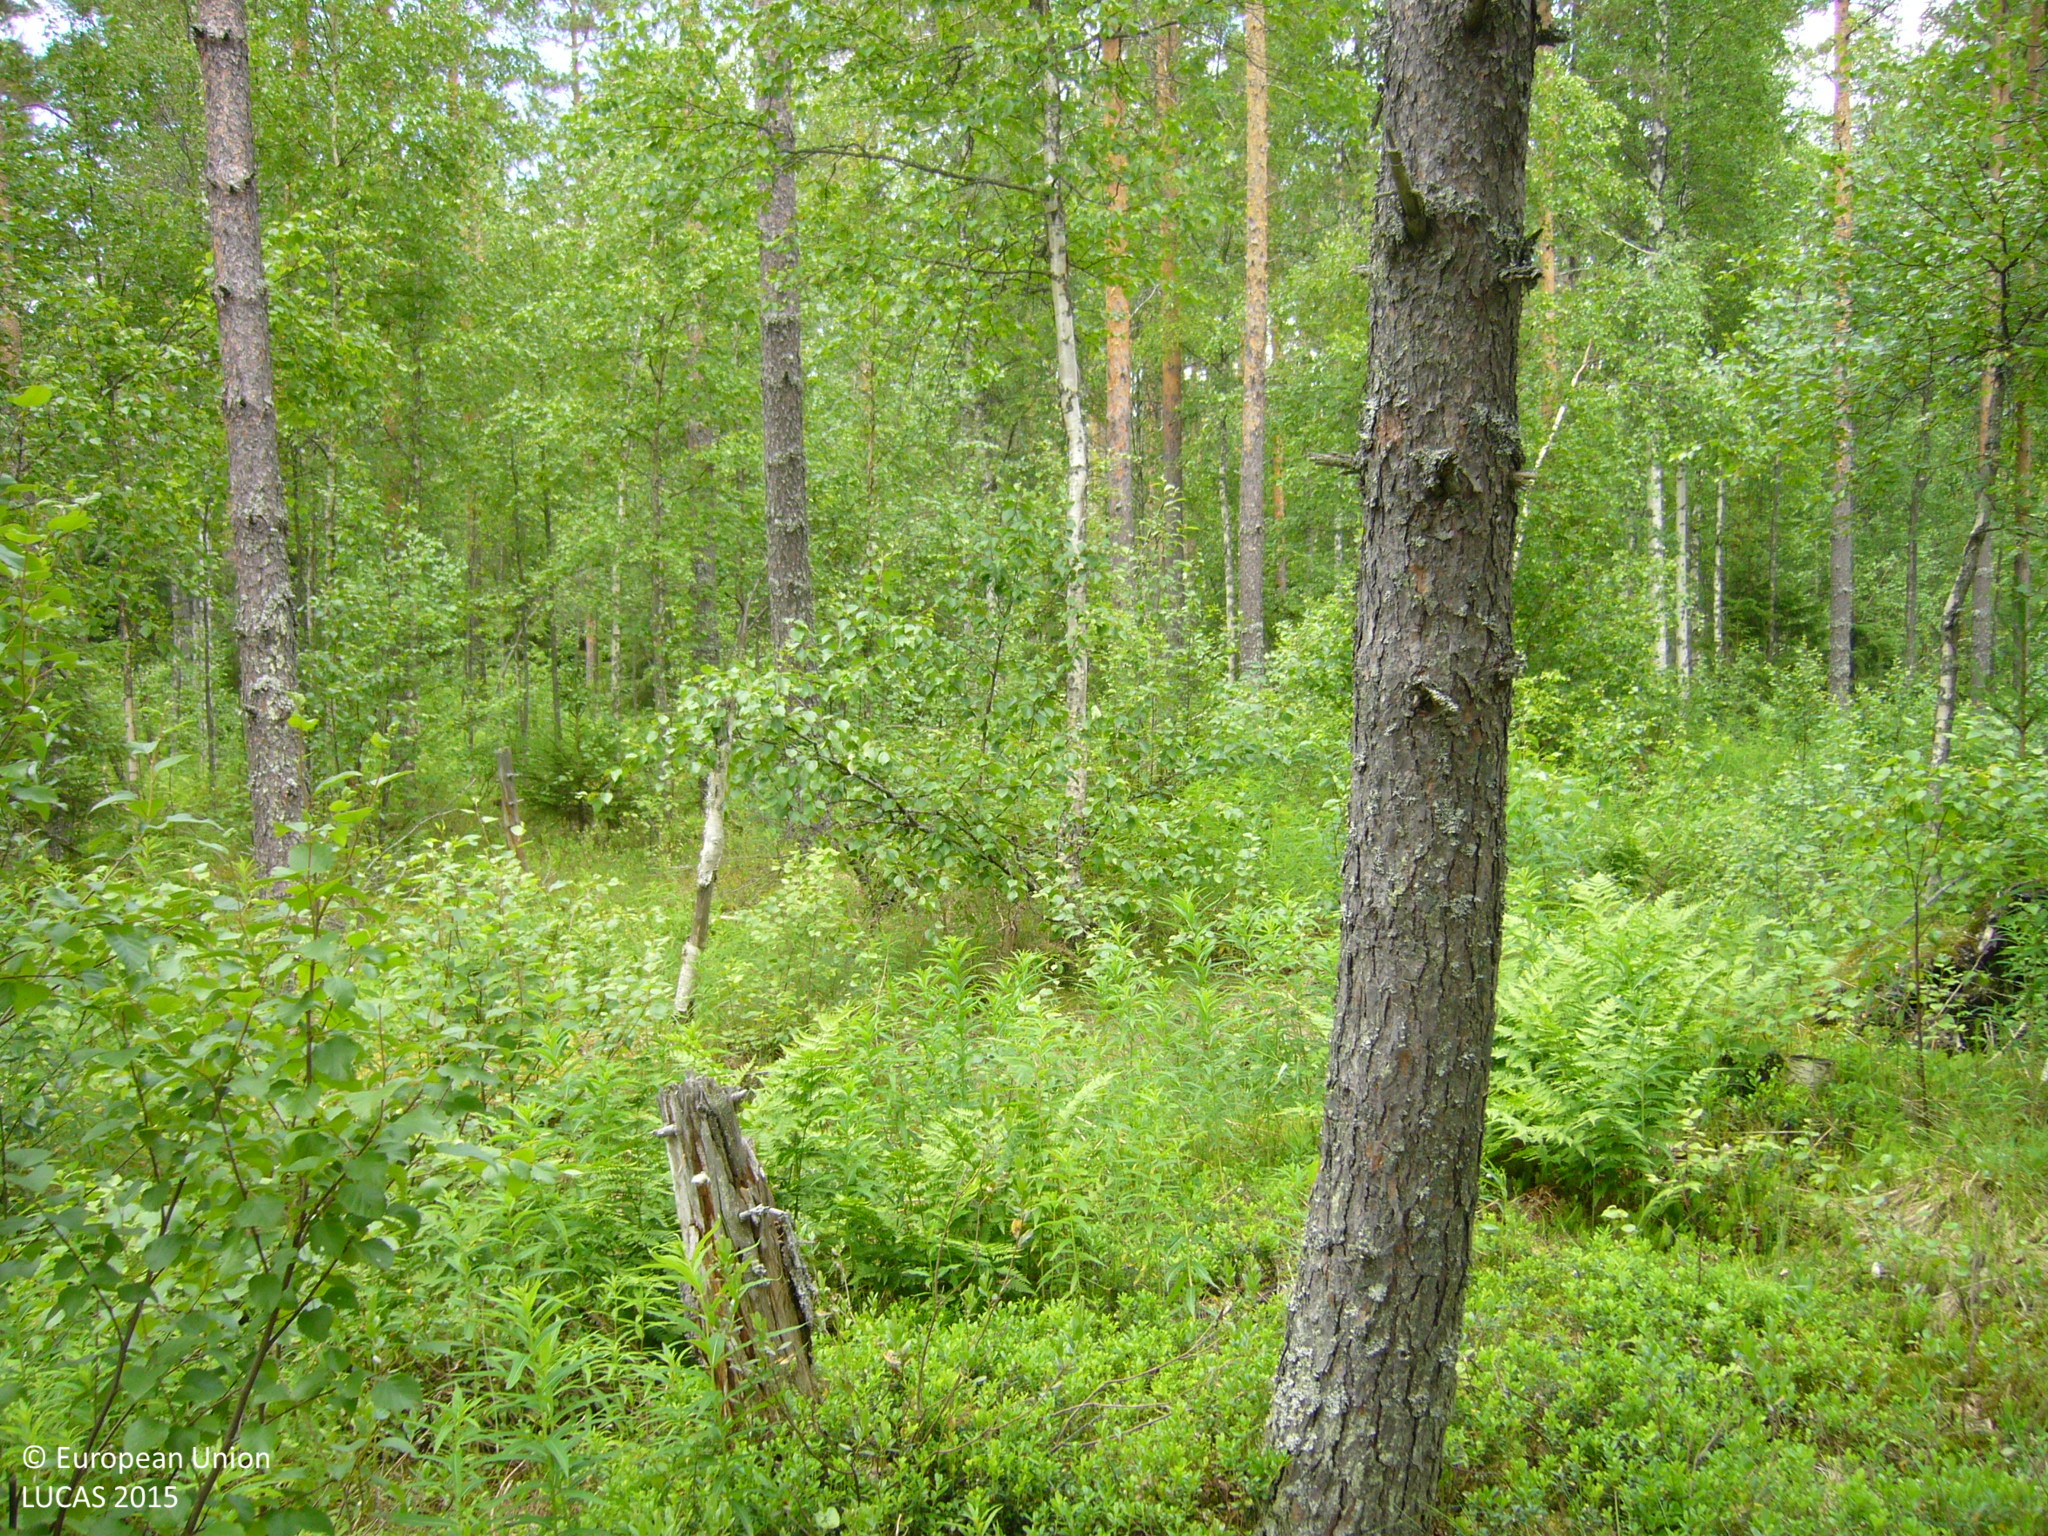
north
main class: Woodland
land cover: Pine dominated mixed woodland
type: boreal forest
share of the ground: 50 - 75 %
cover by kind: broadleaved forest trees 40 %, shrubs 35 %, coniferous forest trees 25 %
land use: Forestry
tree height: > 5 m
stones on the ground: 10 - 25 %
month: July
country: FI
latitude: 63.2345
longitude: 26.1015
